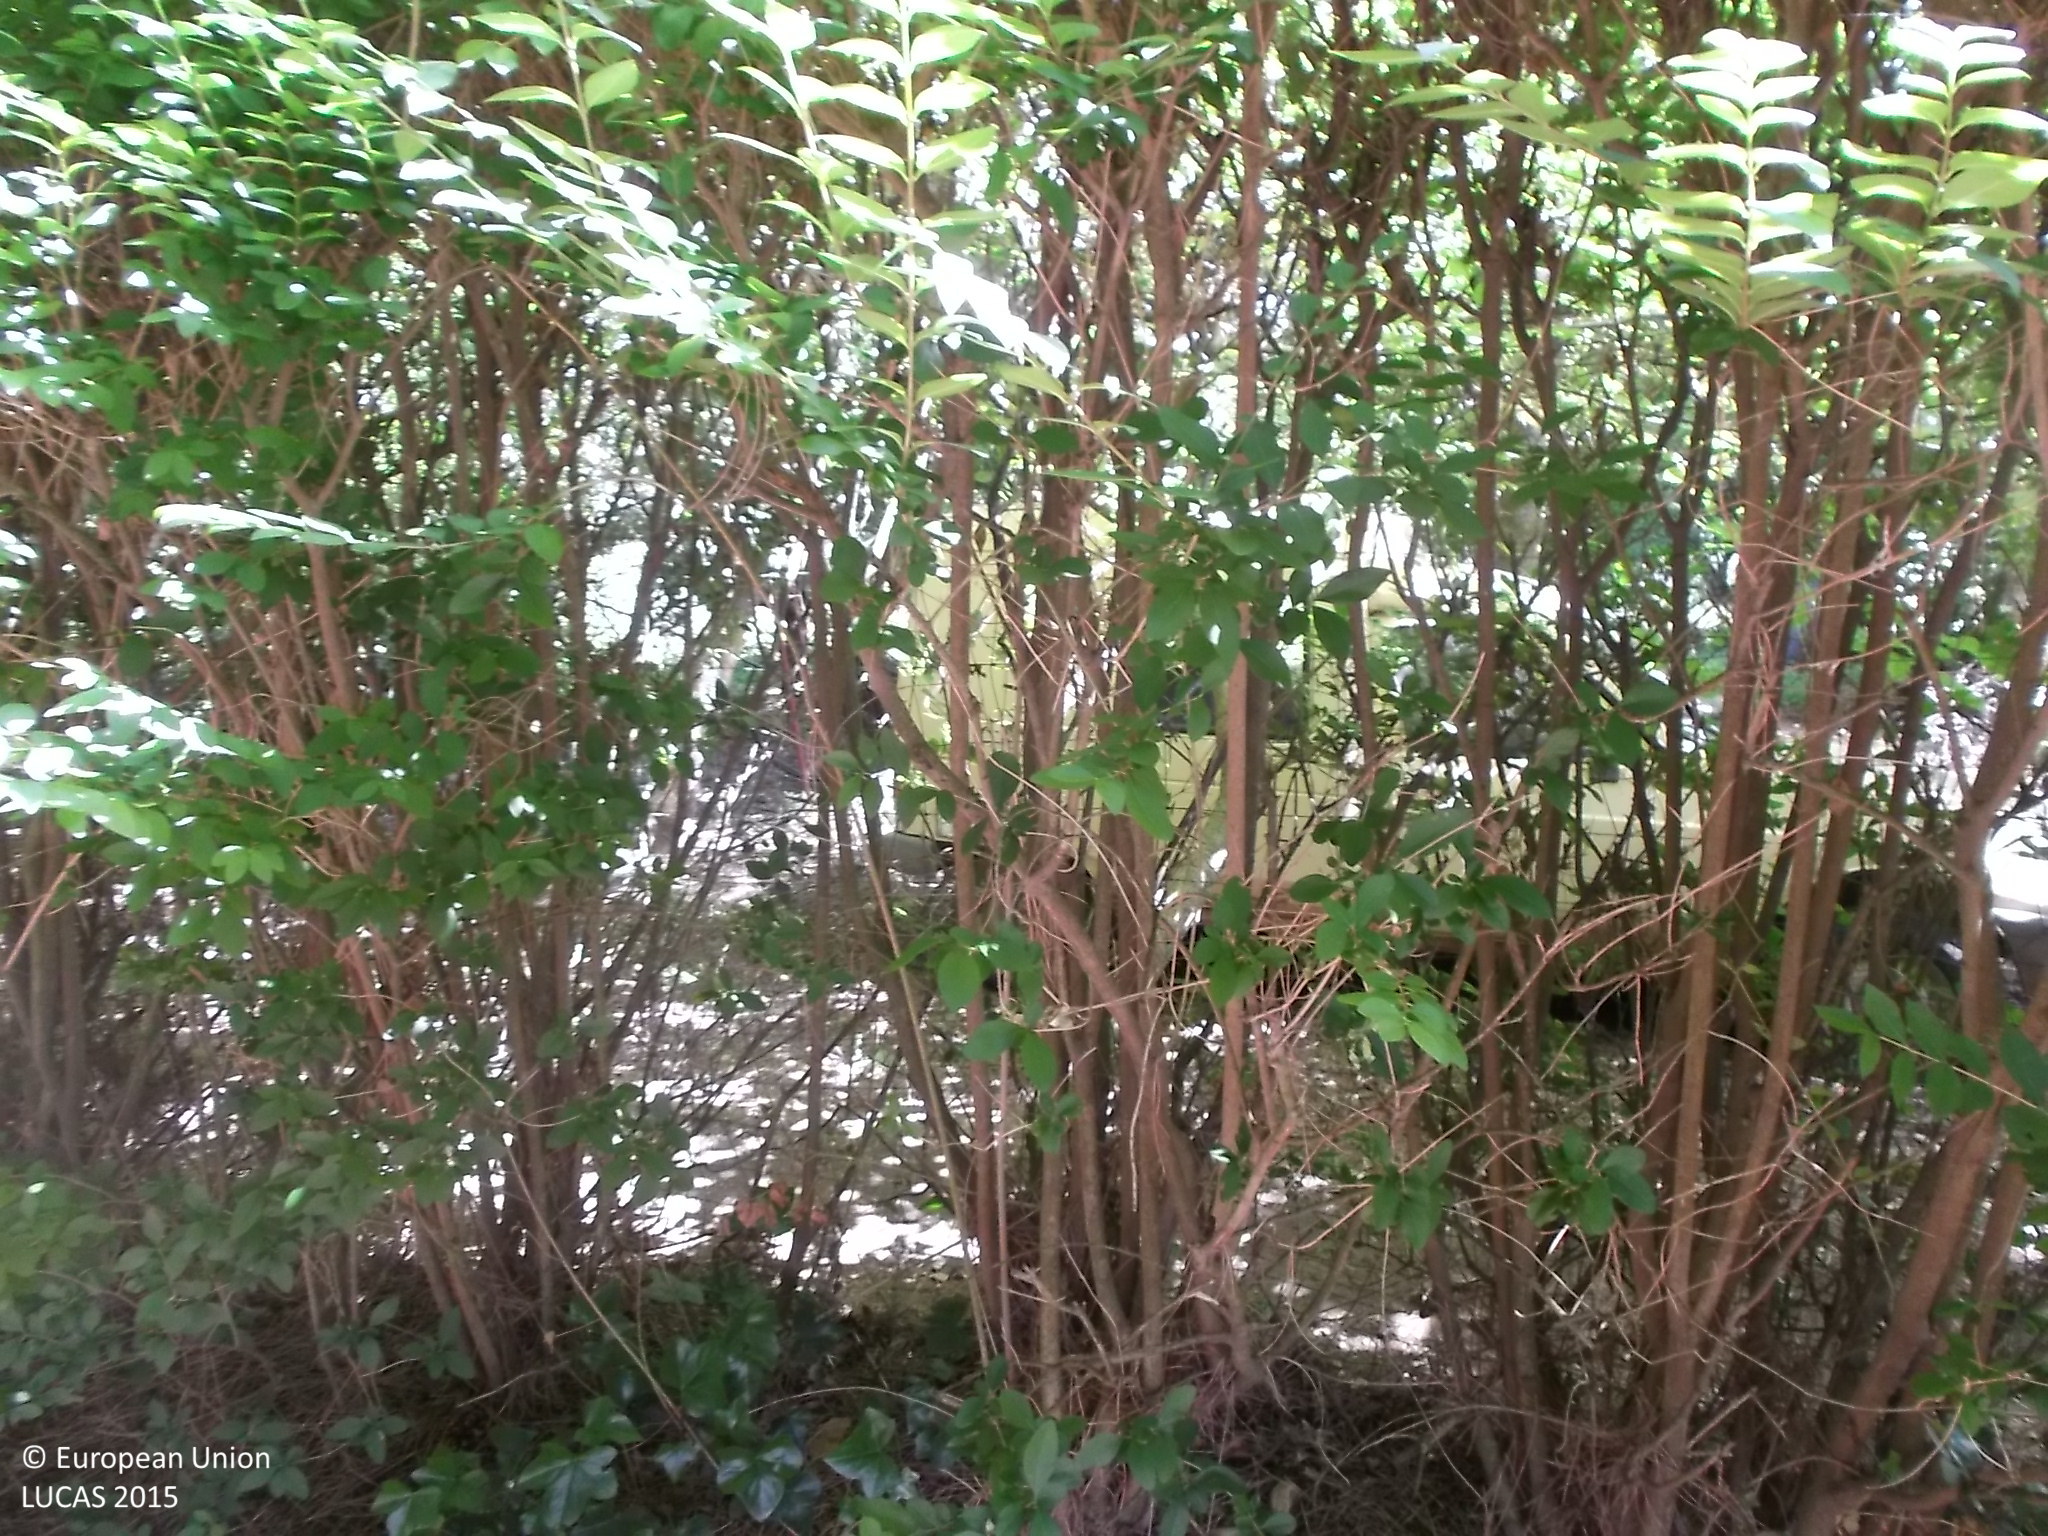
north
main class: Woodland
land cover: Broadleaved woodland
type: broadleaved evergreen forest
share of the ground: > 75 %
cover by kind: broadleaved forest trees 80 %, herbaceous plants 20 %
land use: Residential
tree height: < 5 m
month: July
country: ES
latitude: 41.4904
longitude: -5.3745
